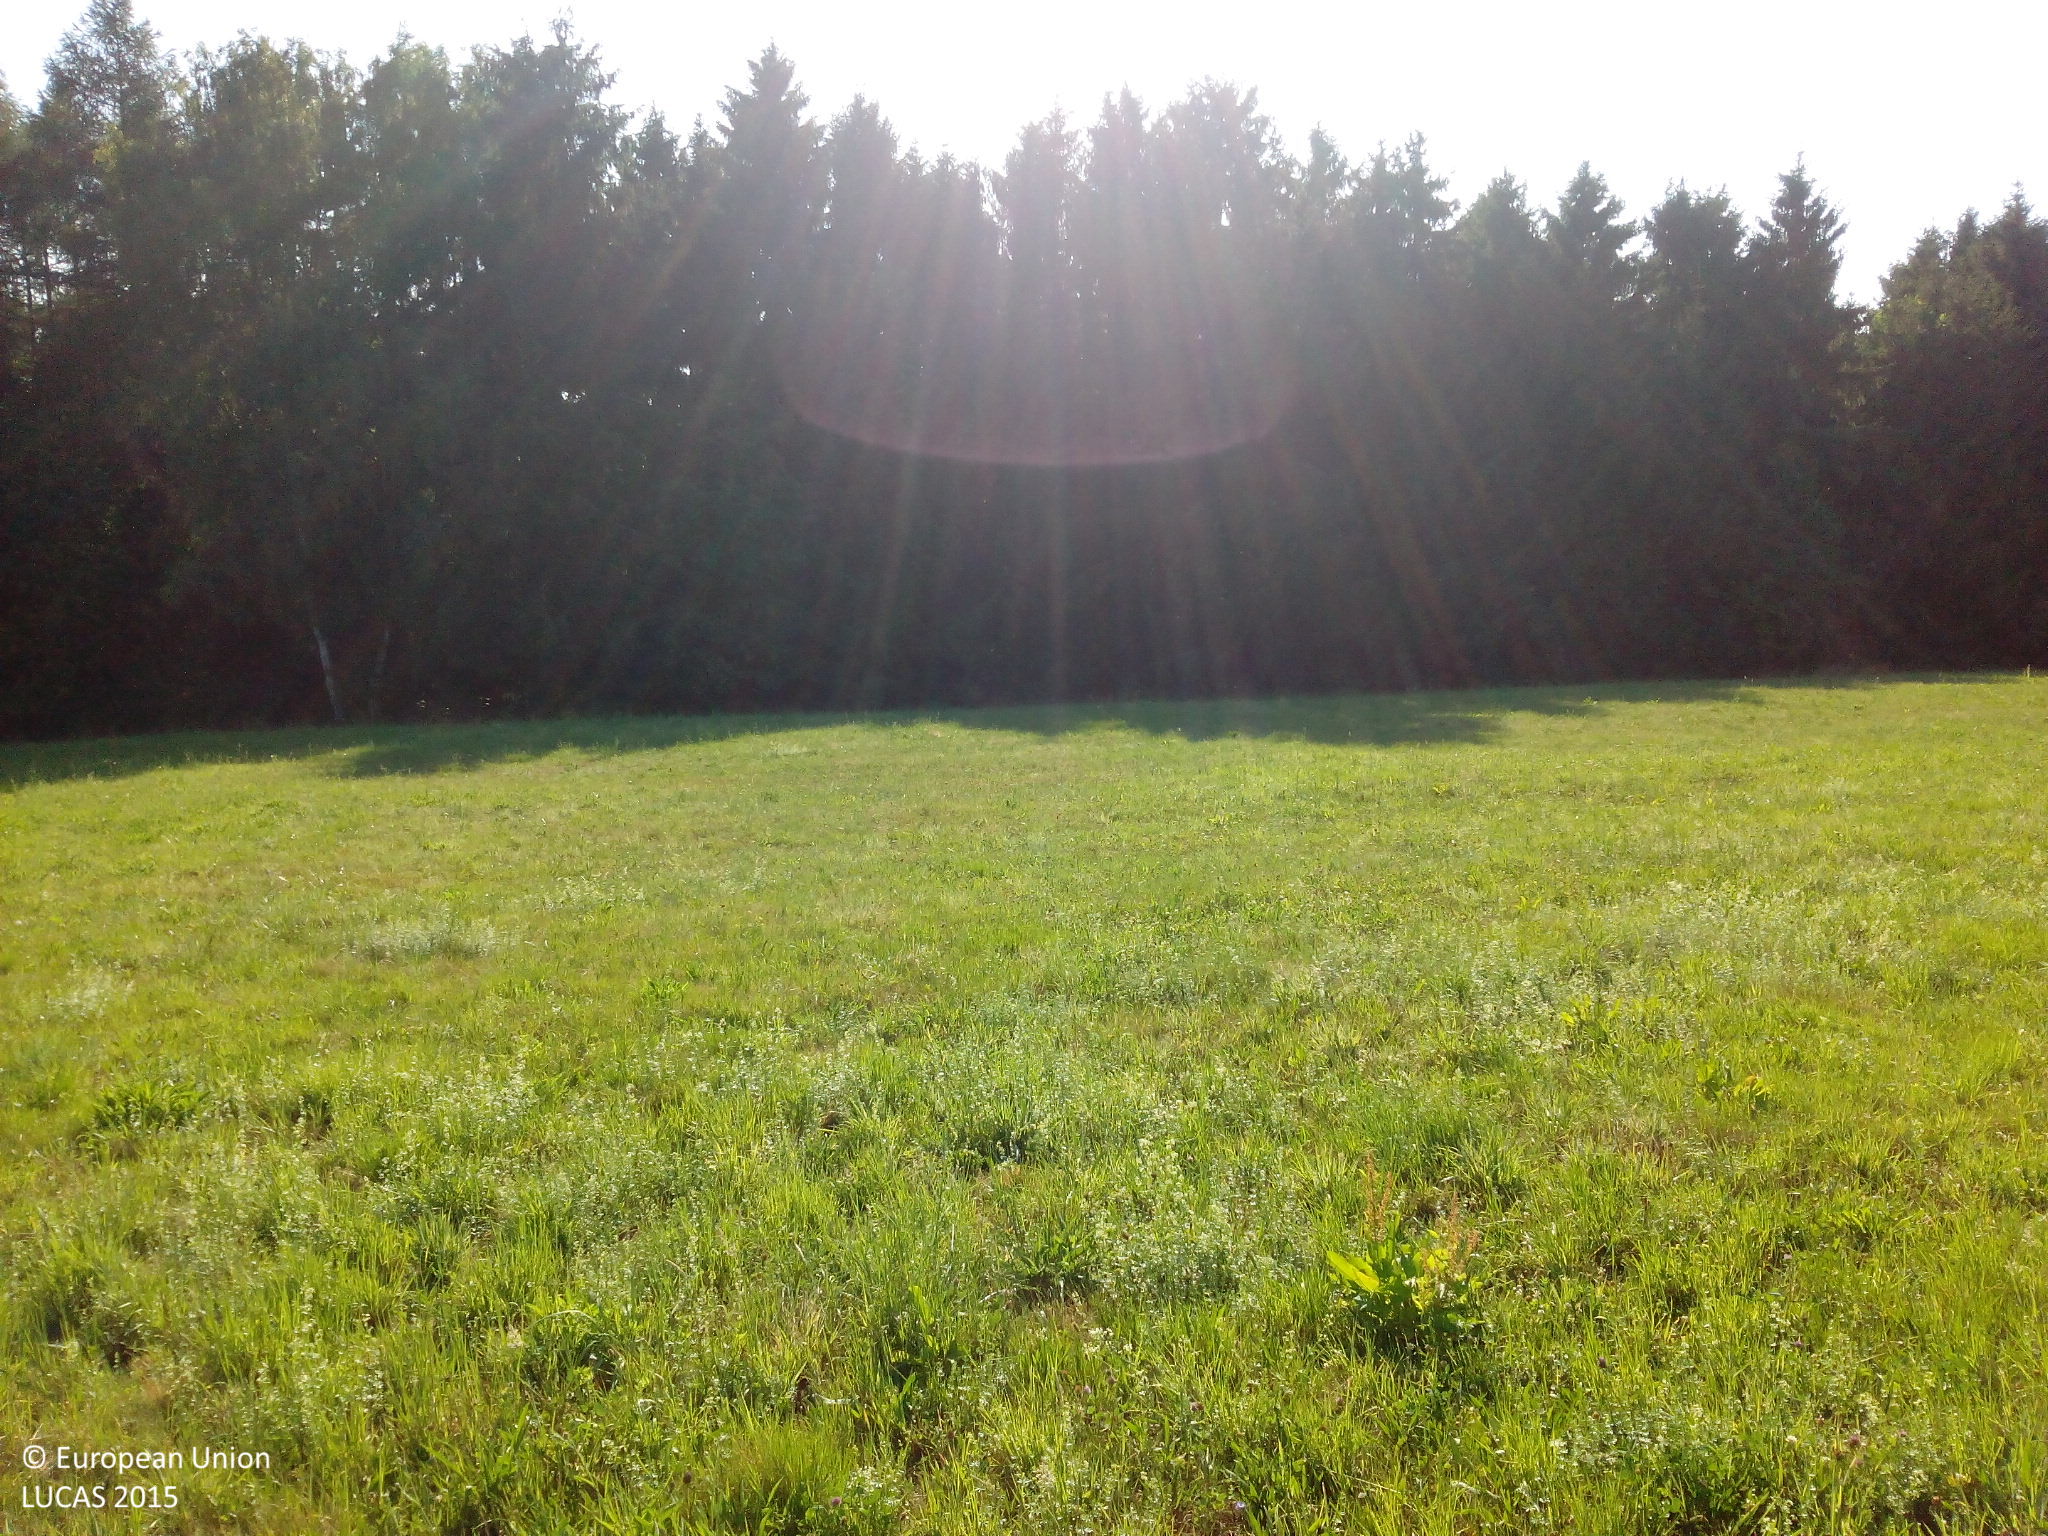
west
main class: Grassland
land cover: Grassland without tree/shrub cover
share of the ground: > 75 %
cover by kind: herbaceous plants 90 %, unconsolidated bare surface 10 %
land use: Agriculture (excluding fallow land and kitchen gardens)
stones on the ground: < 10 %
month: July
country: DE
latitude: 49.1682
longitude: 7.5455
